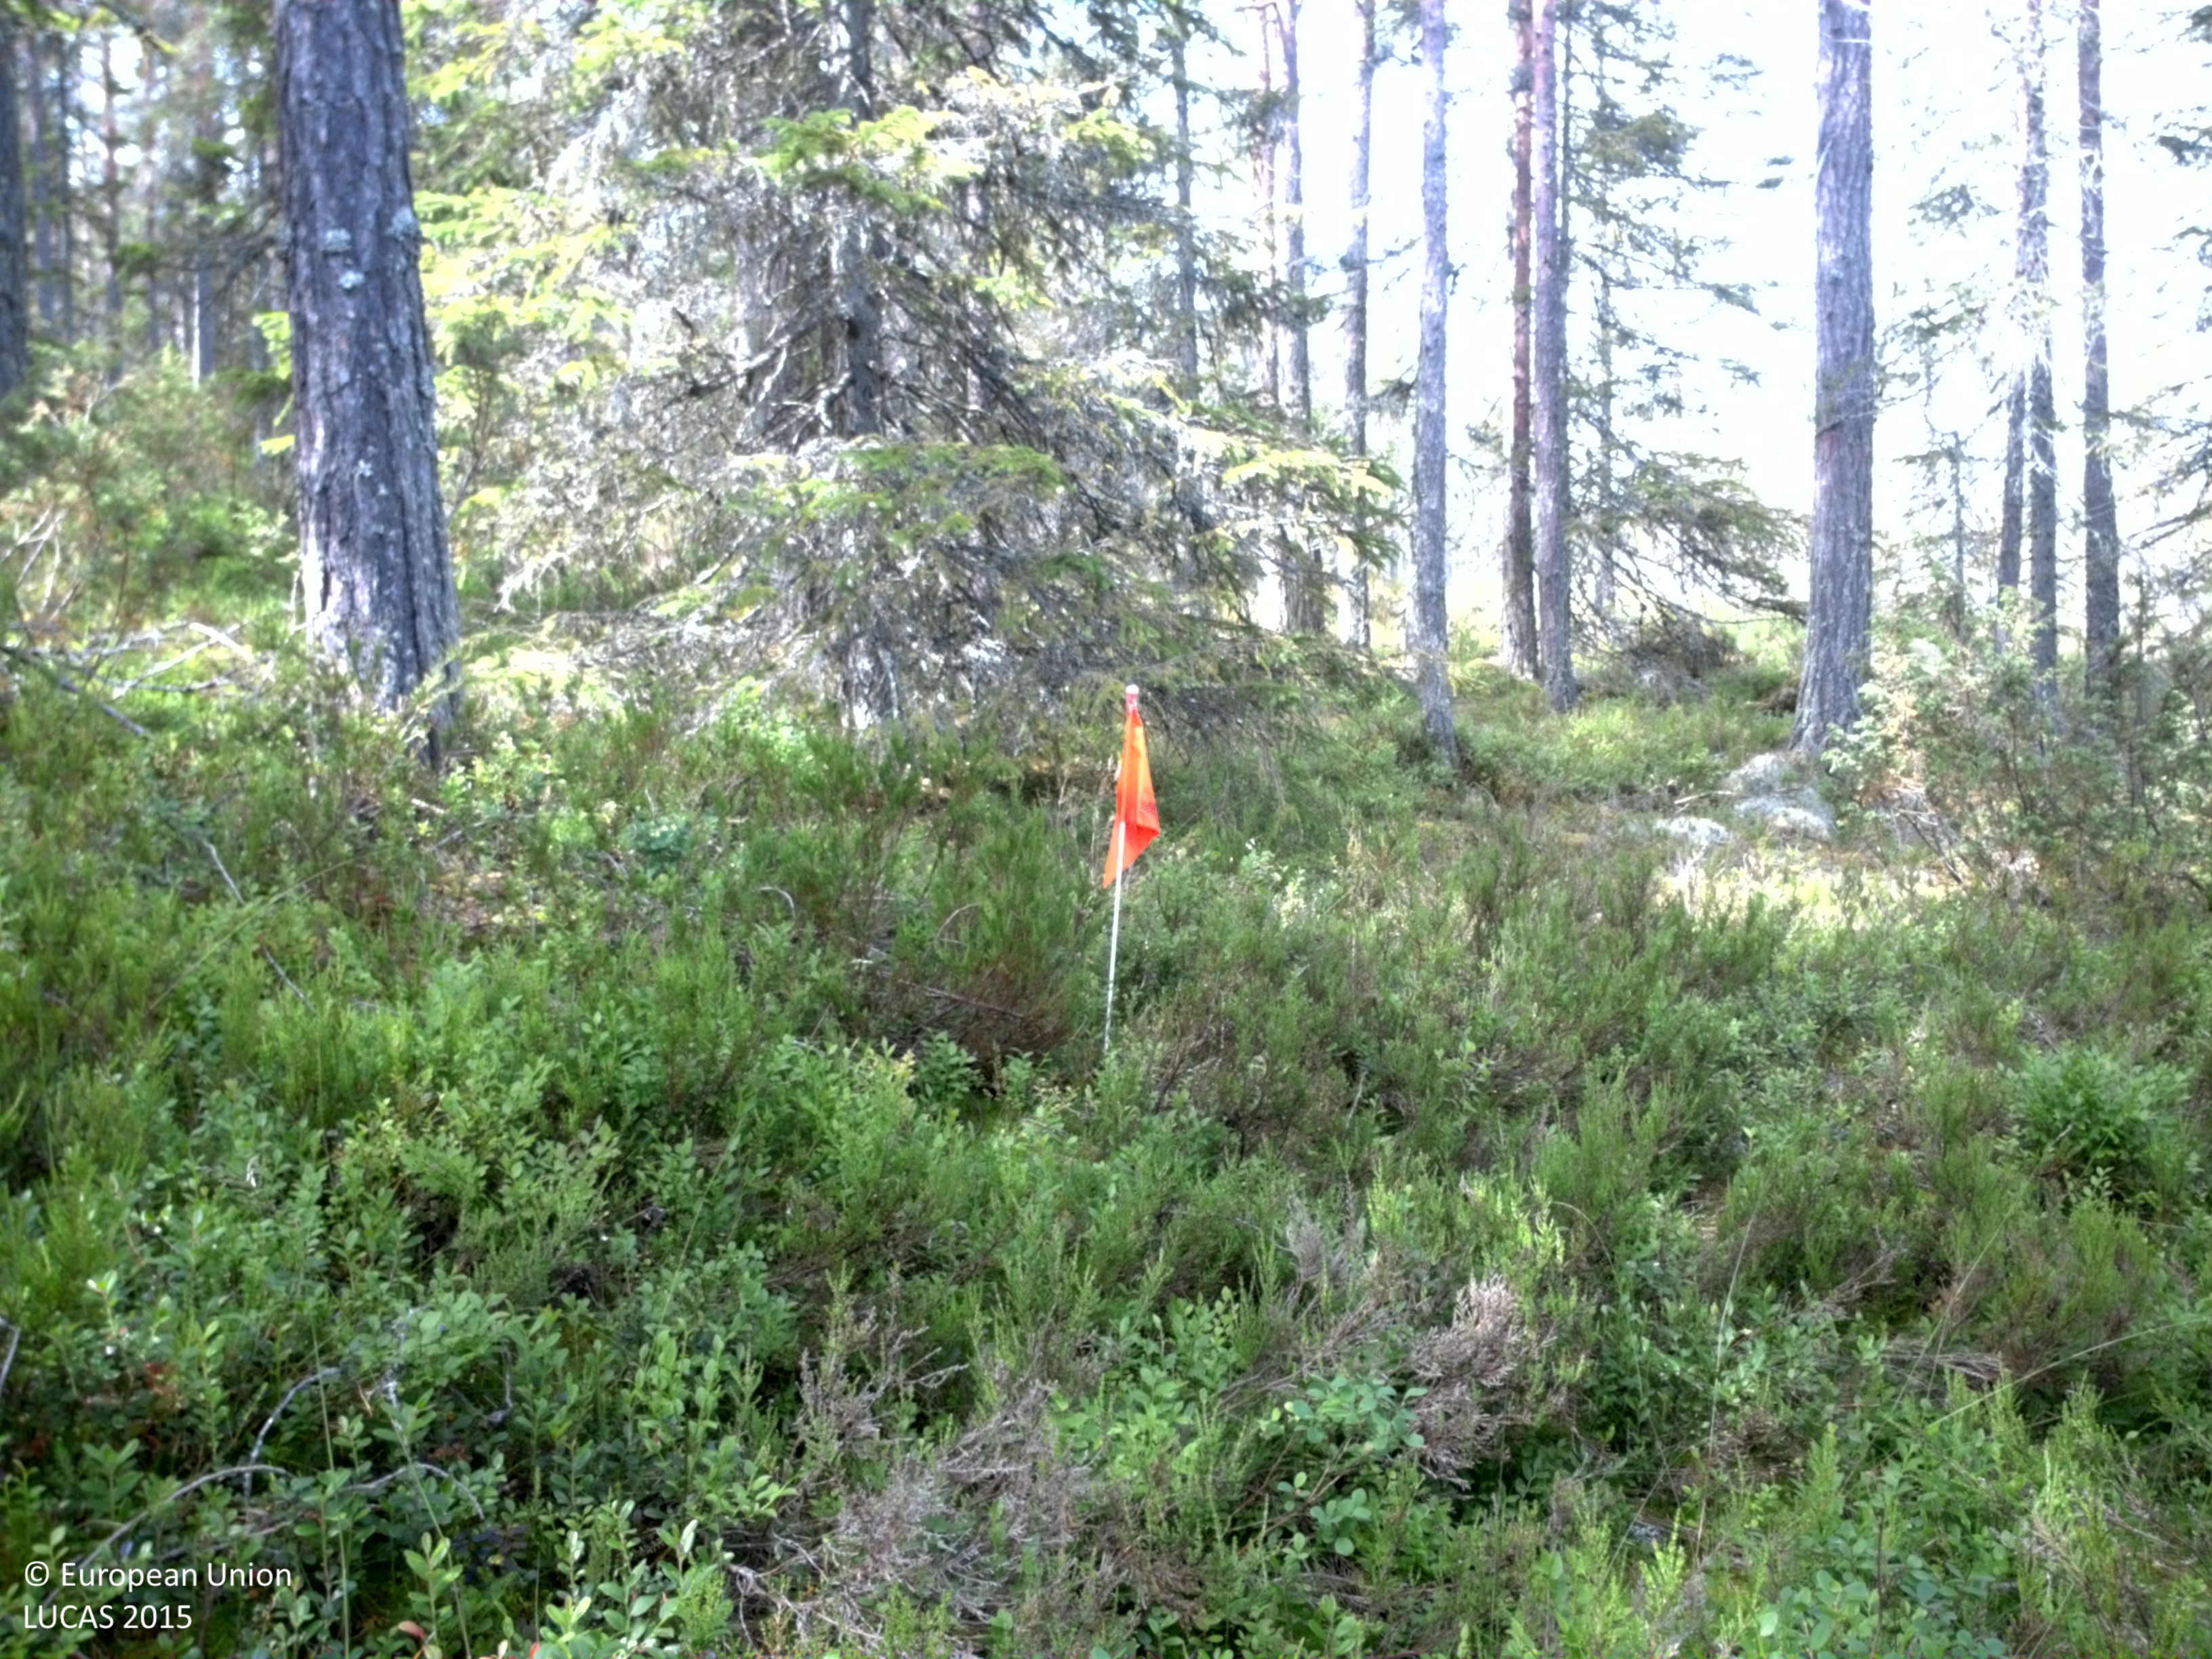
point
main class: Woodland
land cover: Other coniferous woodland
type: boreal forest
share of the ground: 50 - 75 %
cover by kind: coniferous forest trees 65 %, lichens and mosses 25 %, herbaceous plants 10 %
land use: Forestry
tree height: > 5 m
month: July
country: SE
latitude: 61.4326
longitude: 13.6052
